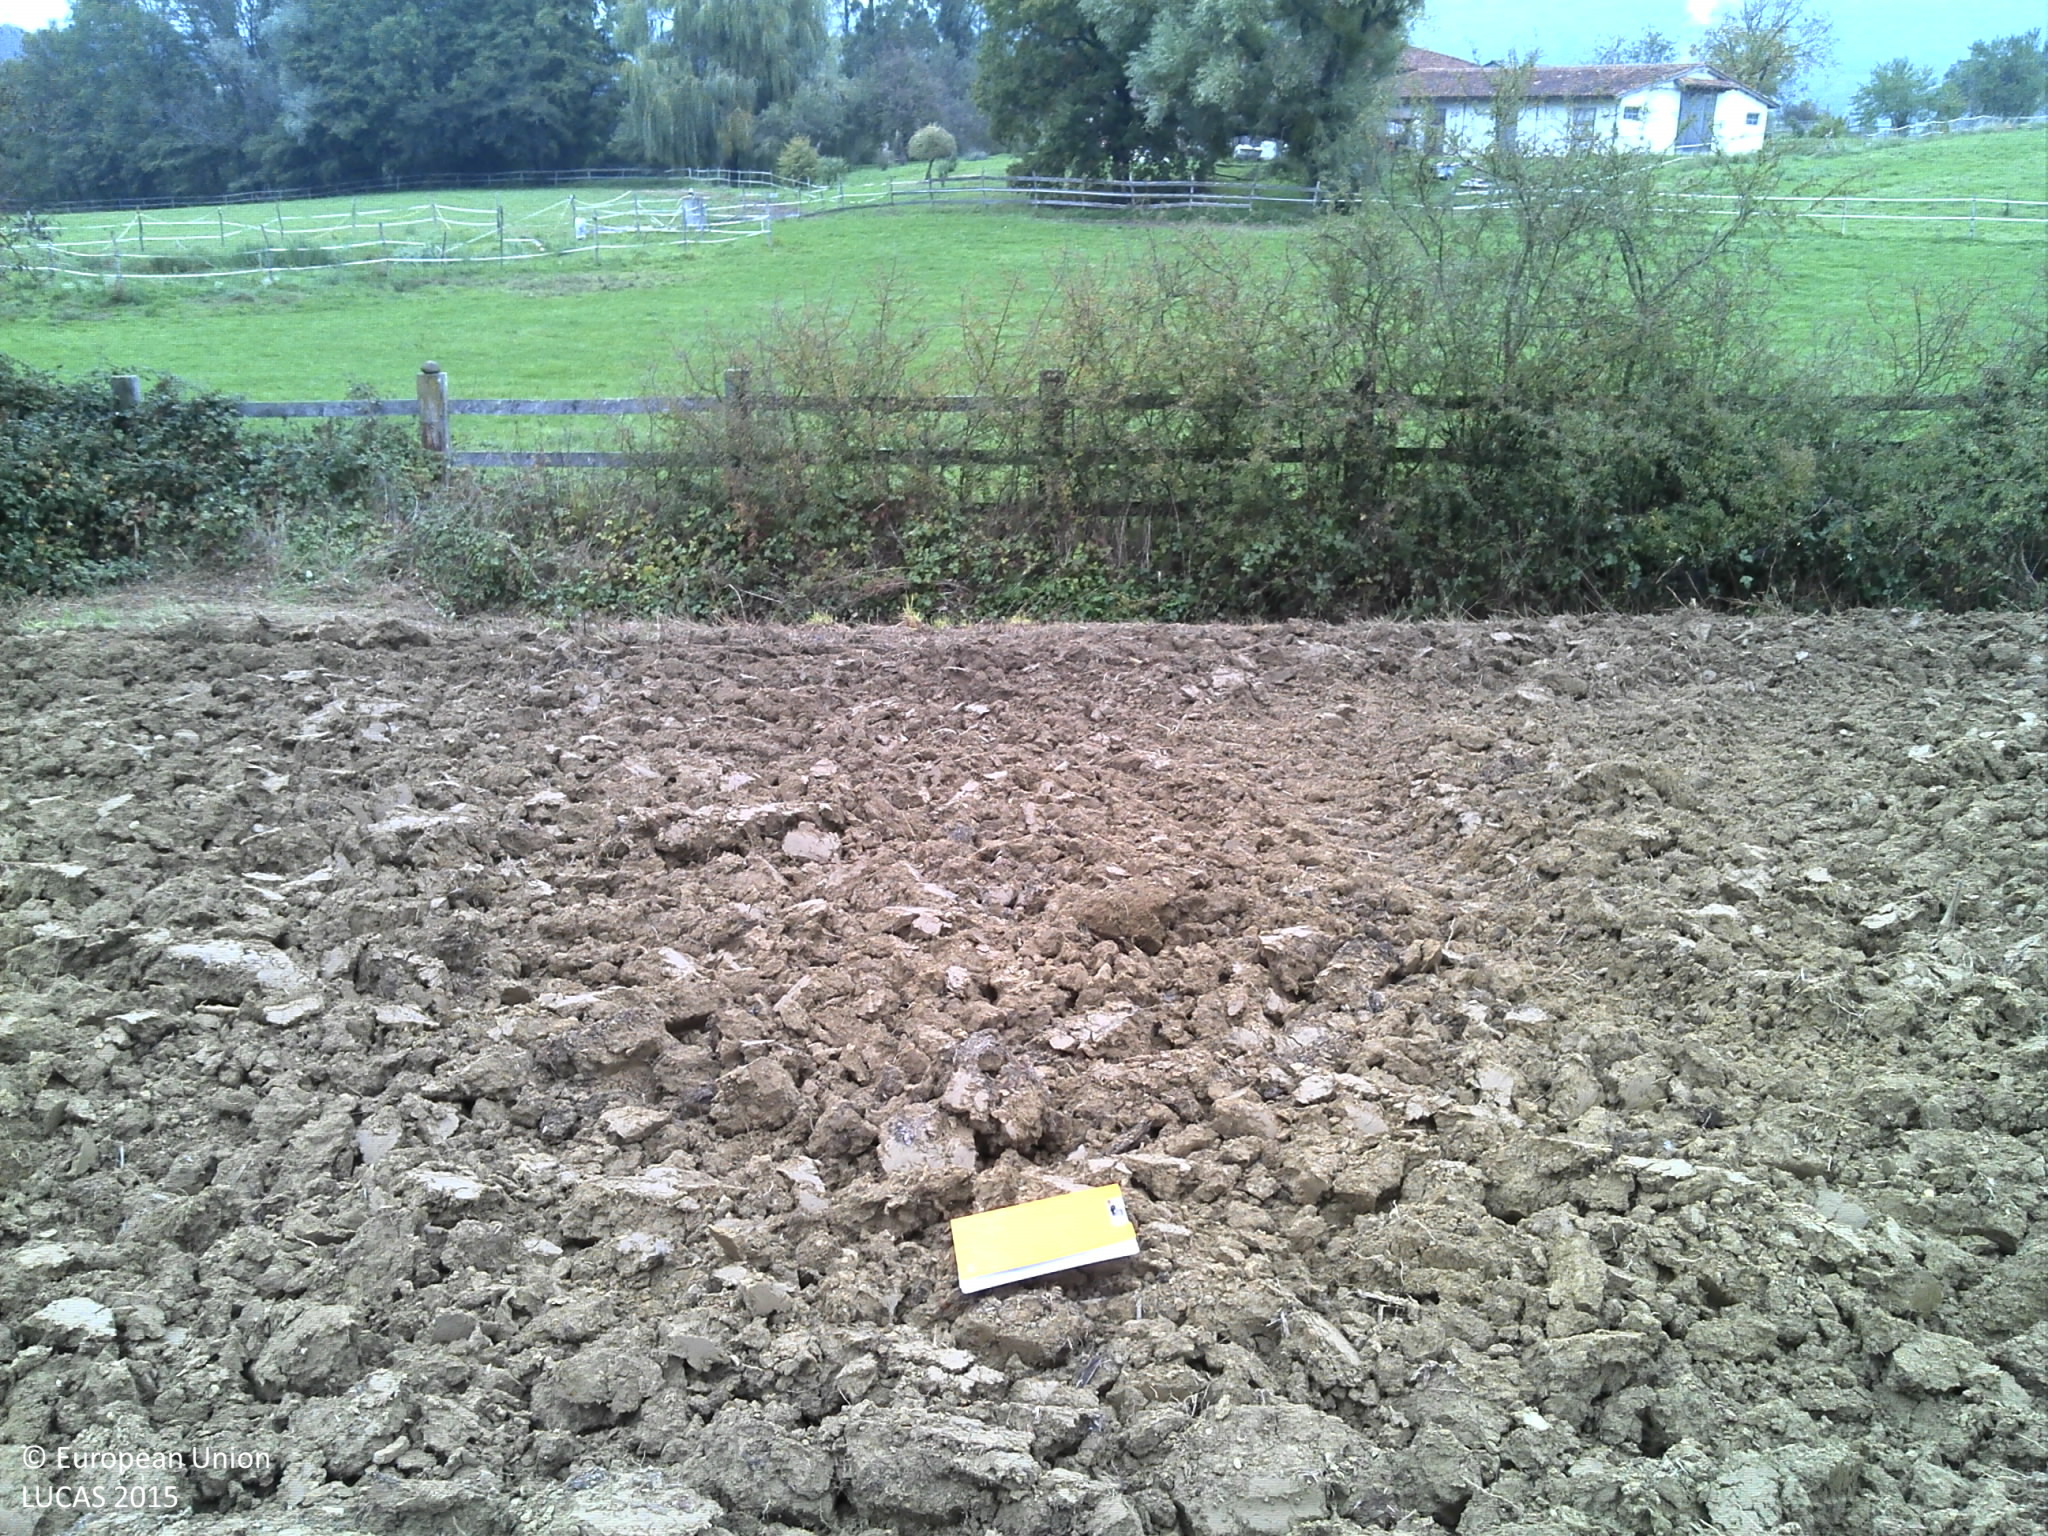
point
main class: Cropland
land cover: Maize
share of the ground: < 10 %
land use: Agriculture (excluding fallow land and kitchen gardens)
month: October
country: FR
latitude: 46.3398
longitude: 5.3386
